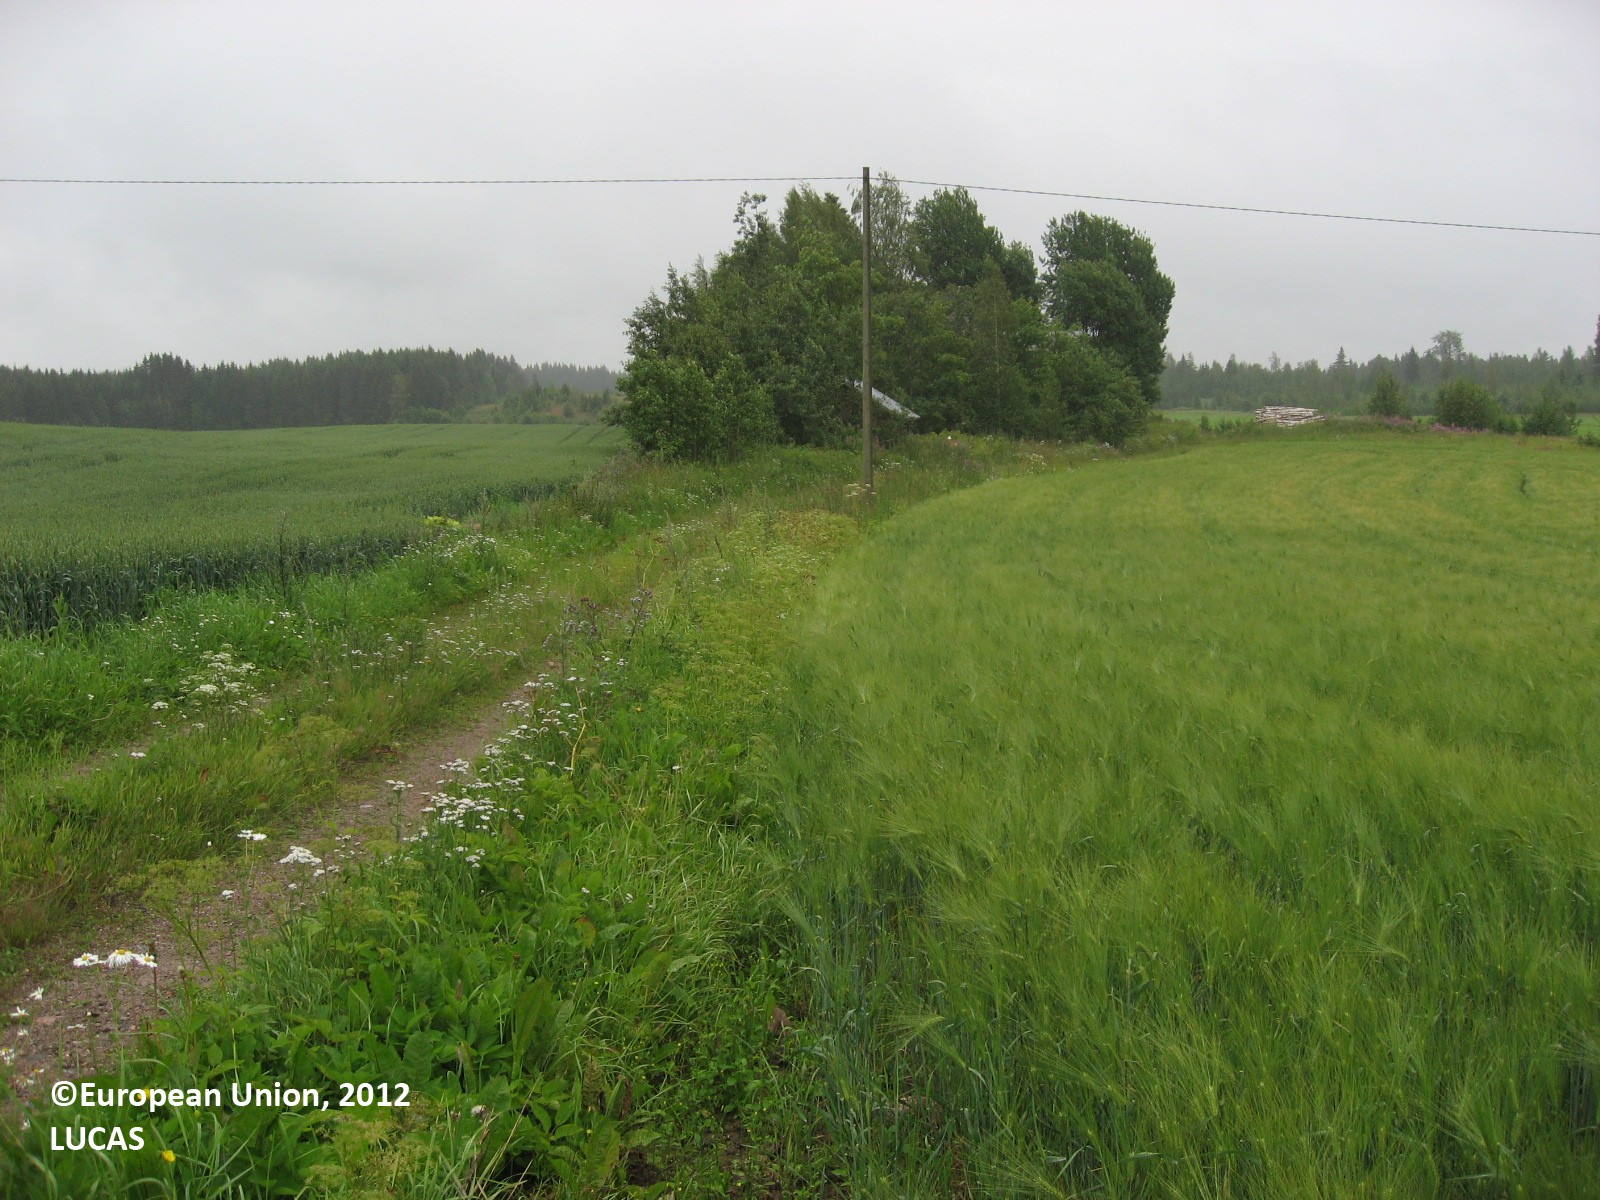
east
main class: Cropland
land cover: Barley
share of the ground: > 75 %
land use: Agriculture (excluding fallow land and kitchen gardens)
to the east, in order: Barley; Electric lines; Barley; Grass margins; Paved roads, cycling and walking lanes; Broadleaved woodland; Artificial constructions in urban areas; Broadleaved woodland; Grass margins; Common wheat; Spontaneously vegetated surfaces; Rivers and streams; Grass margins; Common wheat
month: July
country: FI
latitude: 61.1168
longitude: 25.7004
